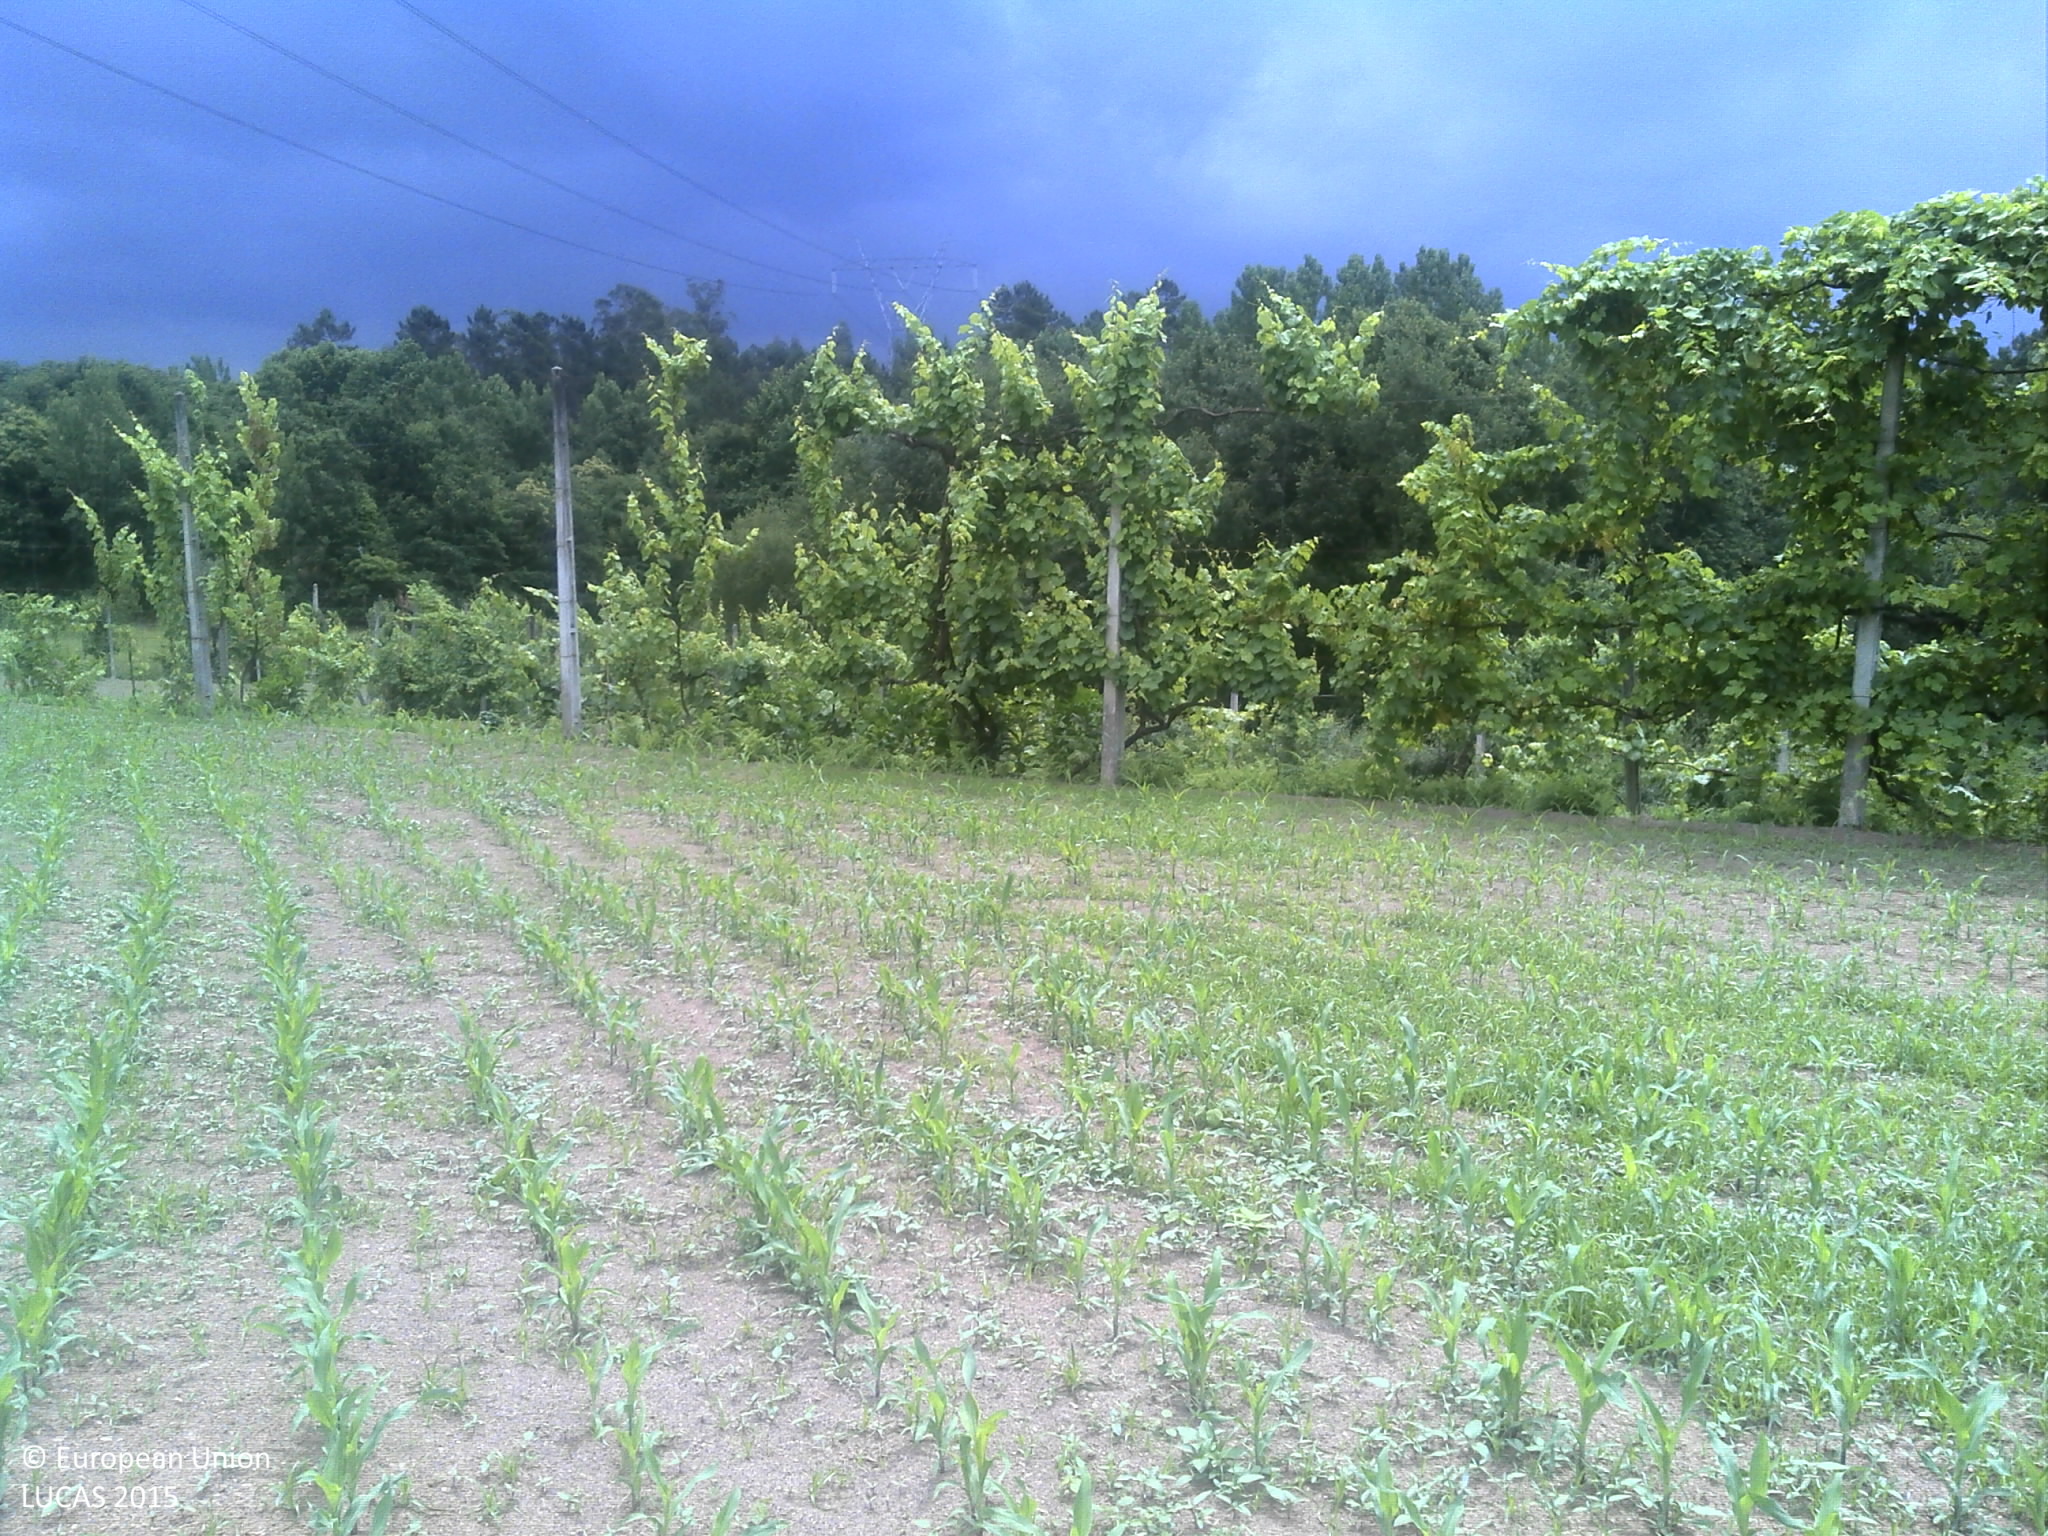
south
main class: Cropland
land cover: Maize
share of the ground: 10 - 25 %
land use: Agriculture (excluding fallow land and kitchen gardens)
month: June
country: PT
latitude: 41.6323
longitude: -8.3139
